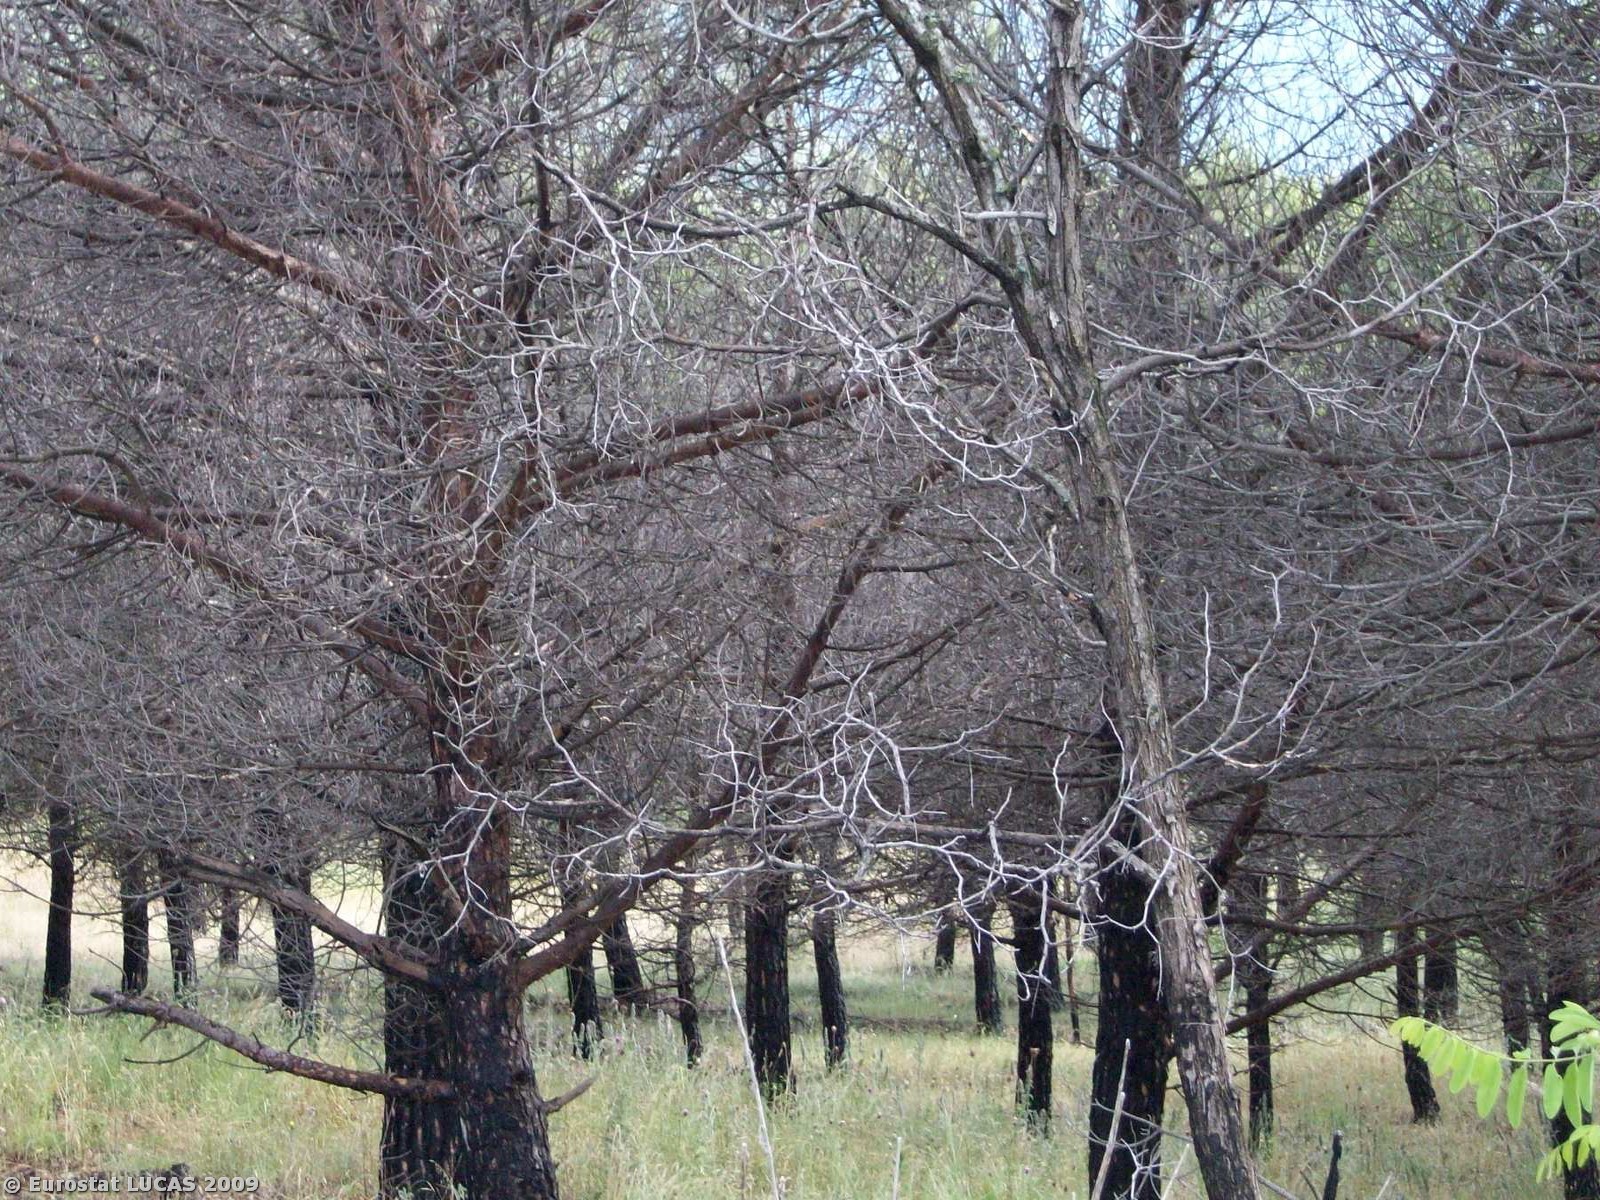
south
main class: Shrubland
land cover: Shrubland with sparse tree cover
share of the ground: > 75 %
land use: Agriculture (excluding fallow land and kitchen gardens)
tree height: > 5 m
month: June
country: IT
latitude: 39.8727
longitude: 16.1811
